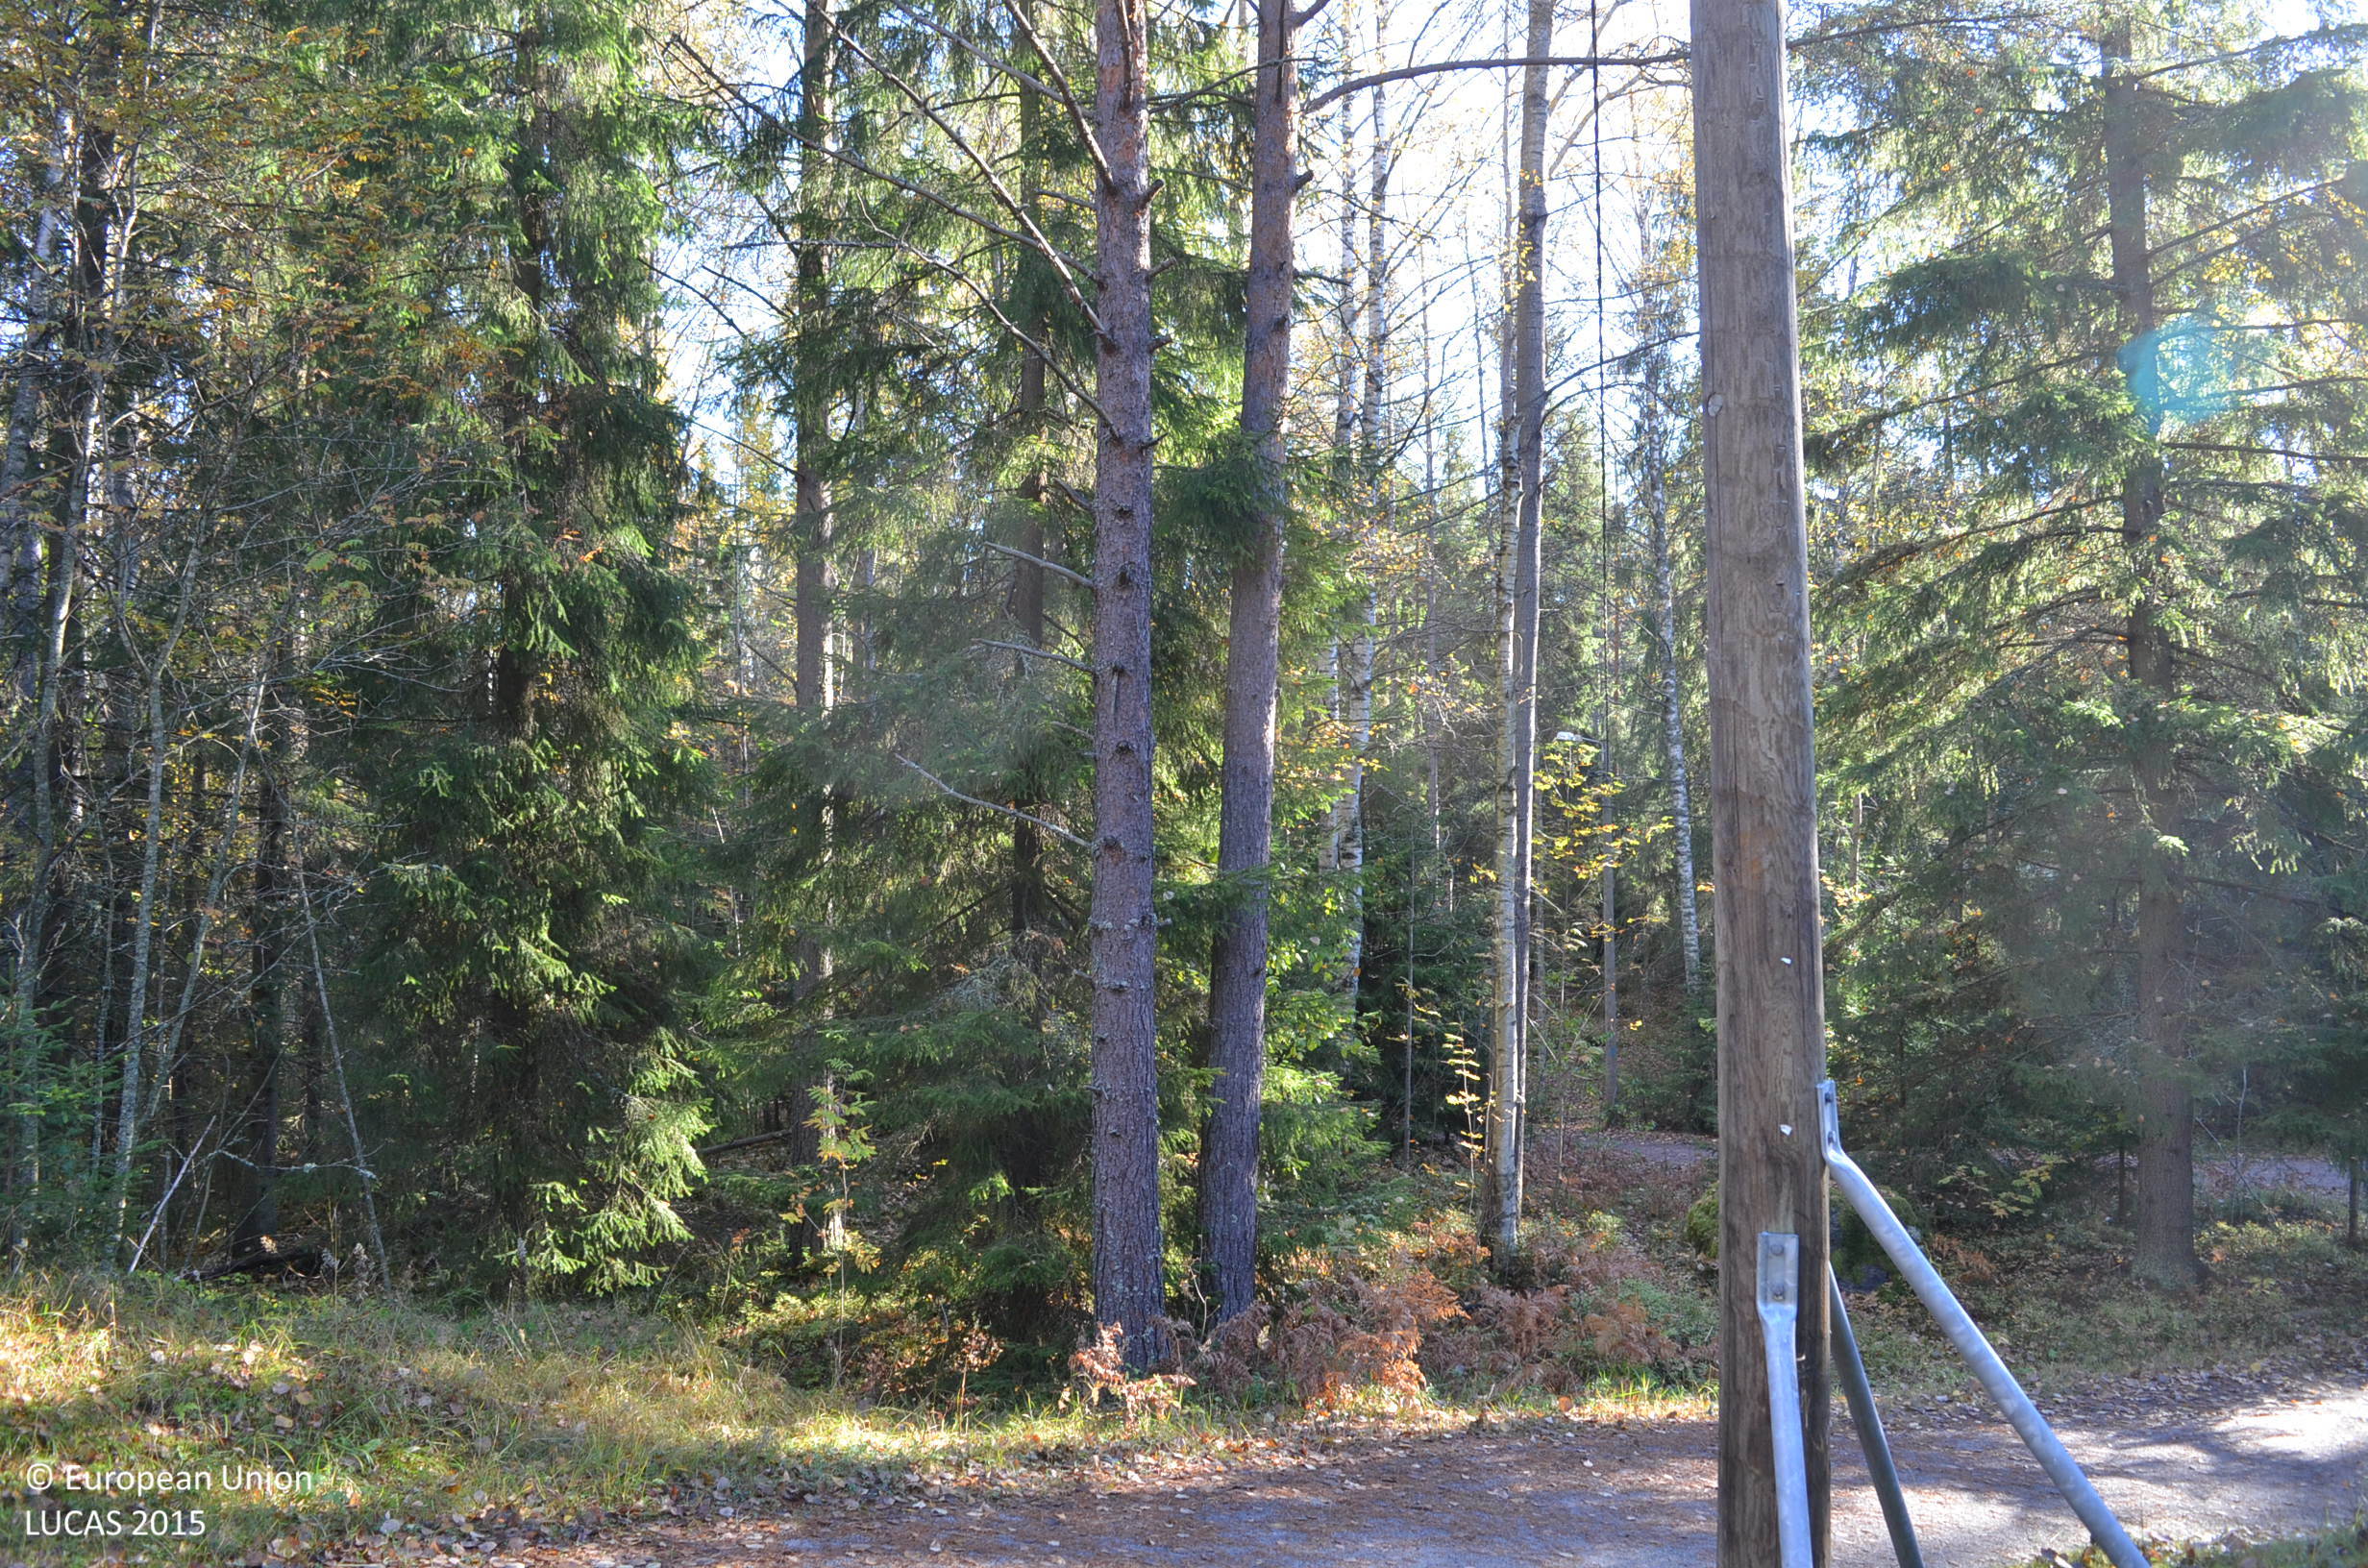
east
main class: Woodland
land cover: Other mixed woodland
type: boreal forest
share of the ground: 50 - 75 %
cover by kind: coniferous forest trees 40 %, broadleaved forest trees 30 %, shrubs 15 %, lichens and mosses 10 %
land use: Amenities, museums, leisure
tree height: > 5 m
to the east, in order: Other mixed woodland; Electric lines; Tracks; Other mixed woodland; Tracks; Electric lines; Spruce dominated mixed woodland; Ditches and canals; Spruce dominated mixed woodland
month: October
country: FI
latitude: 61.5118
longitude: 23.8234
